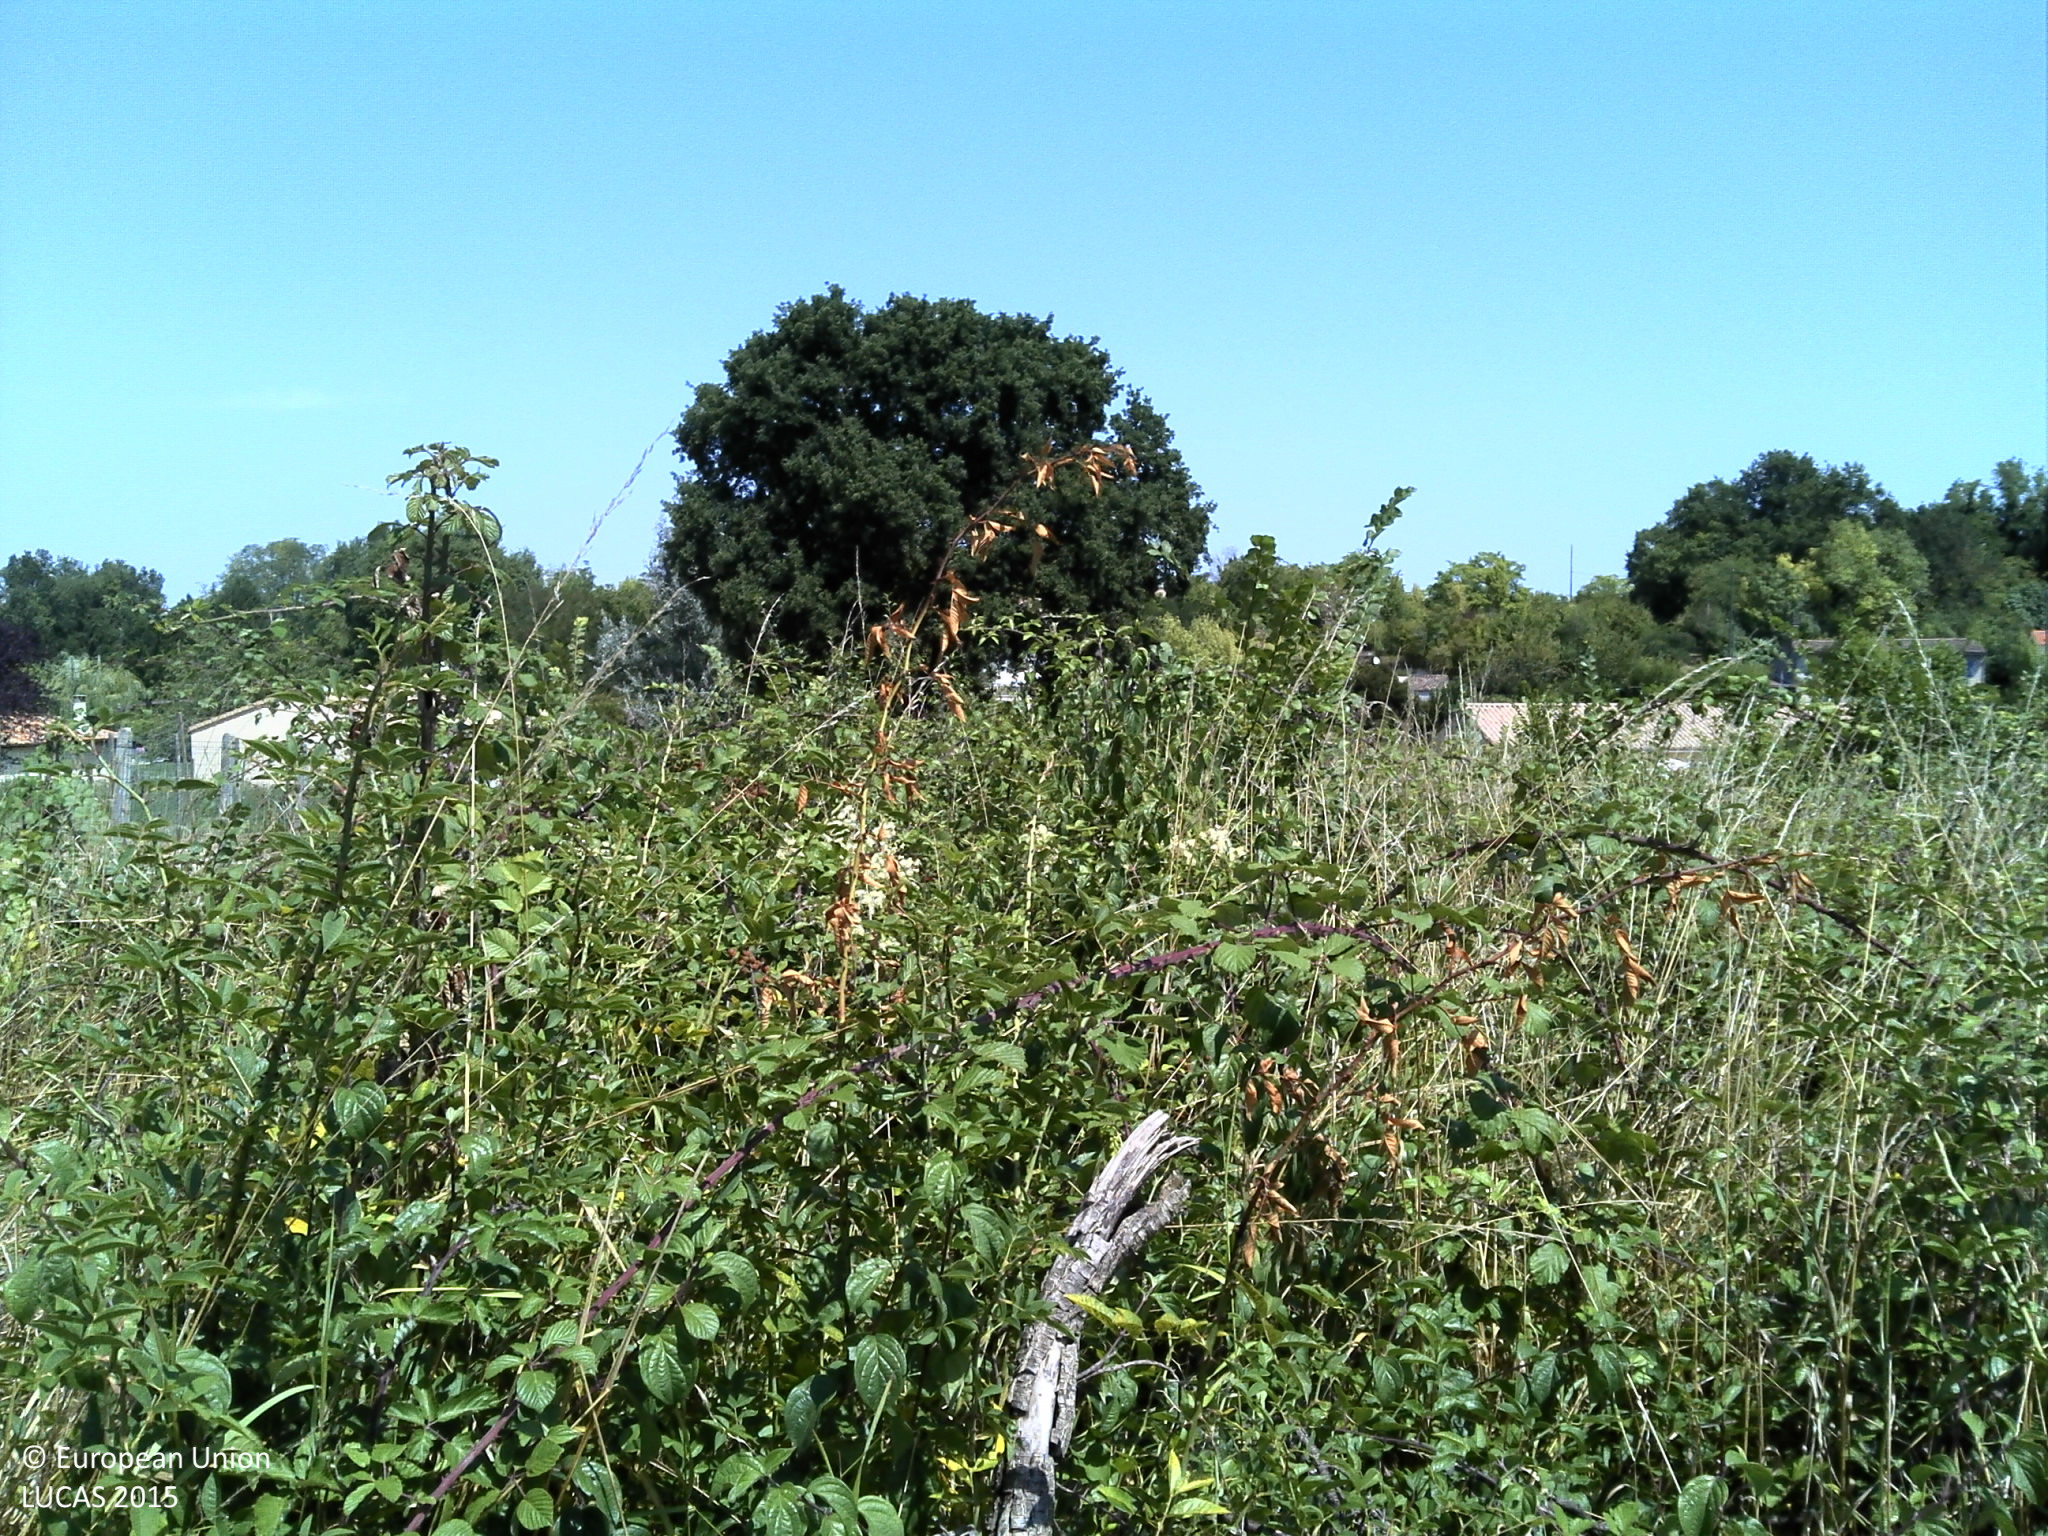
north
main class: Shrubland
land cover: Shrubland without tree cover
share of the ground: > 75 %
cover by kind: shrubs 100 %
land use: Semi-natural and natural areas not in use
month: August
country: FR
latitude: 45.0348
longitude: -0.4910
